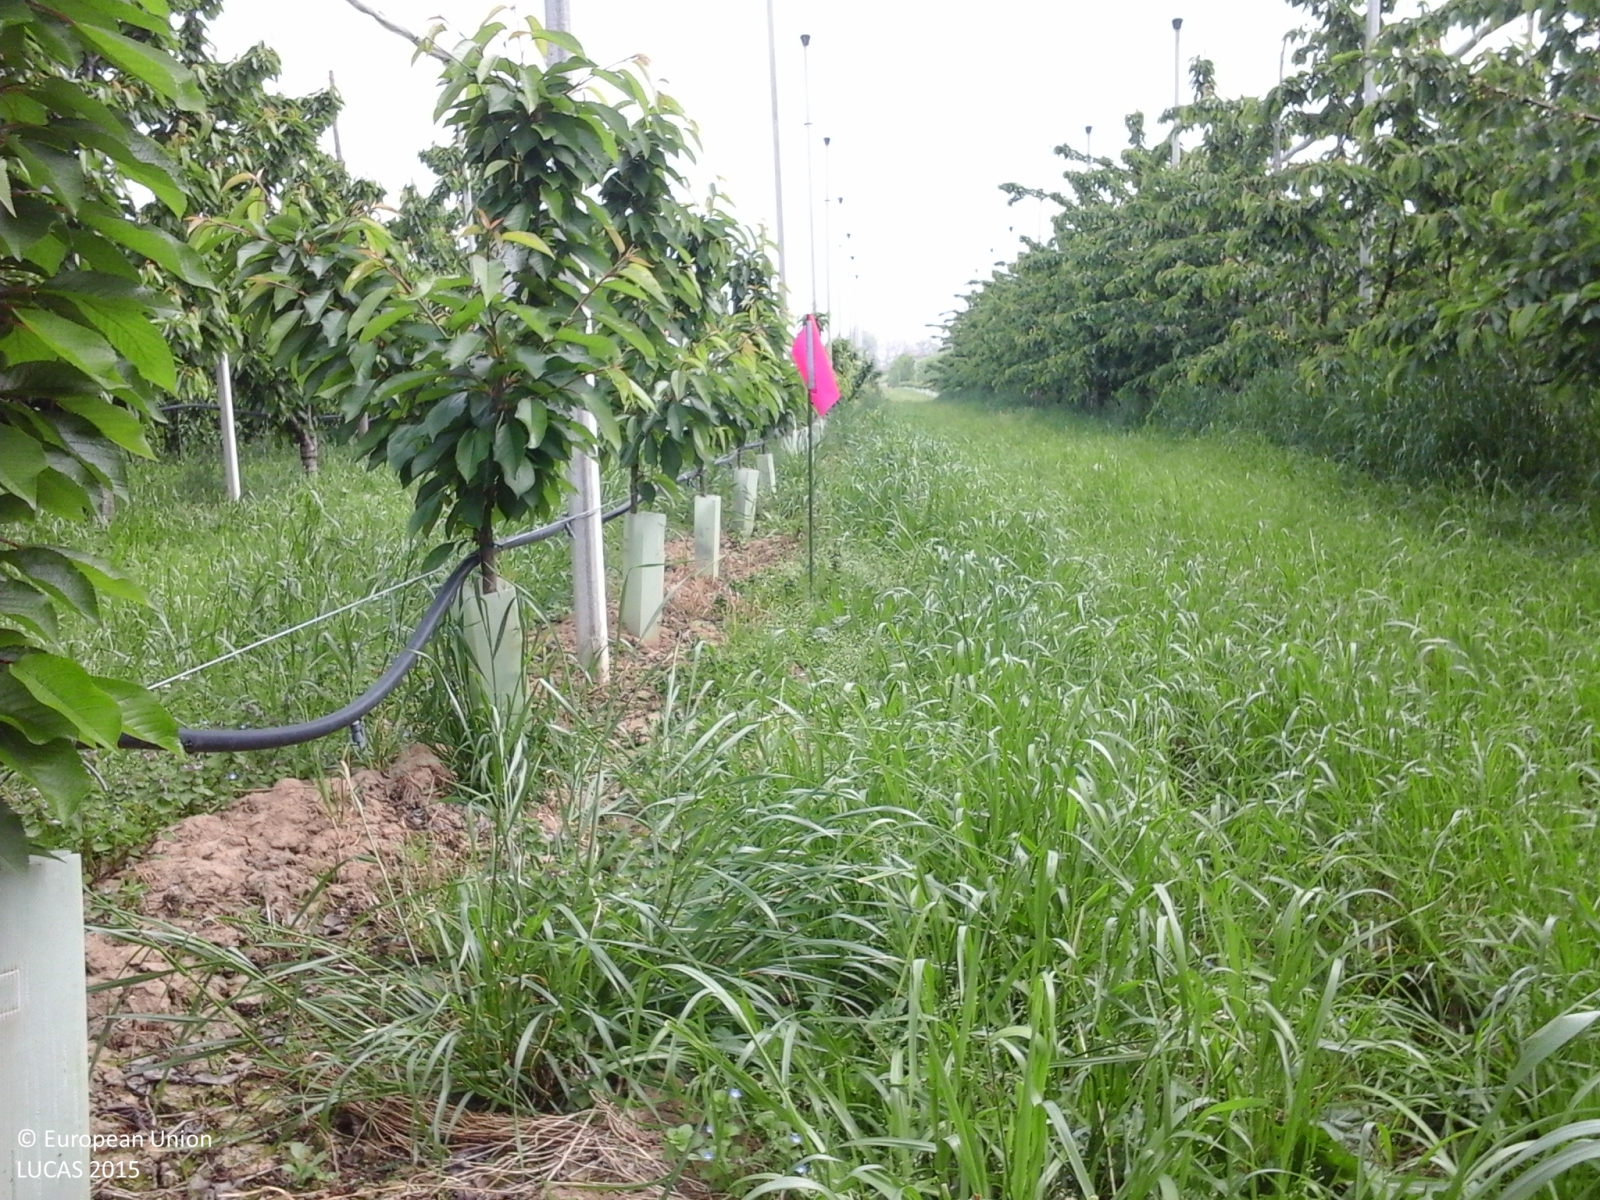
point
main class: Cropland
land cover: Cherry fruit
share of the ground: 50 - 75 %
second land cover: Grassland without tree/shrub cover
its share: > 75 %
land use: Agriculture (excluding fallow land and kitchen gardens)
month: May
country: IT
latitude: 44.4896
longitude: 11.0414
